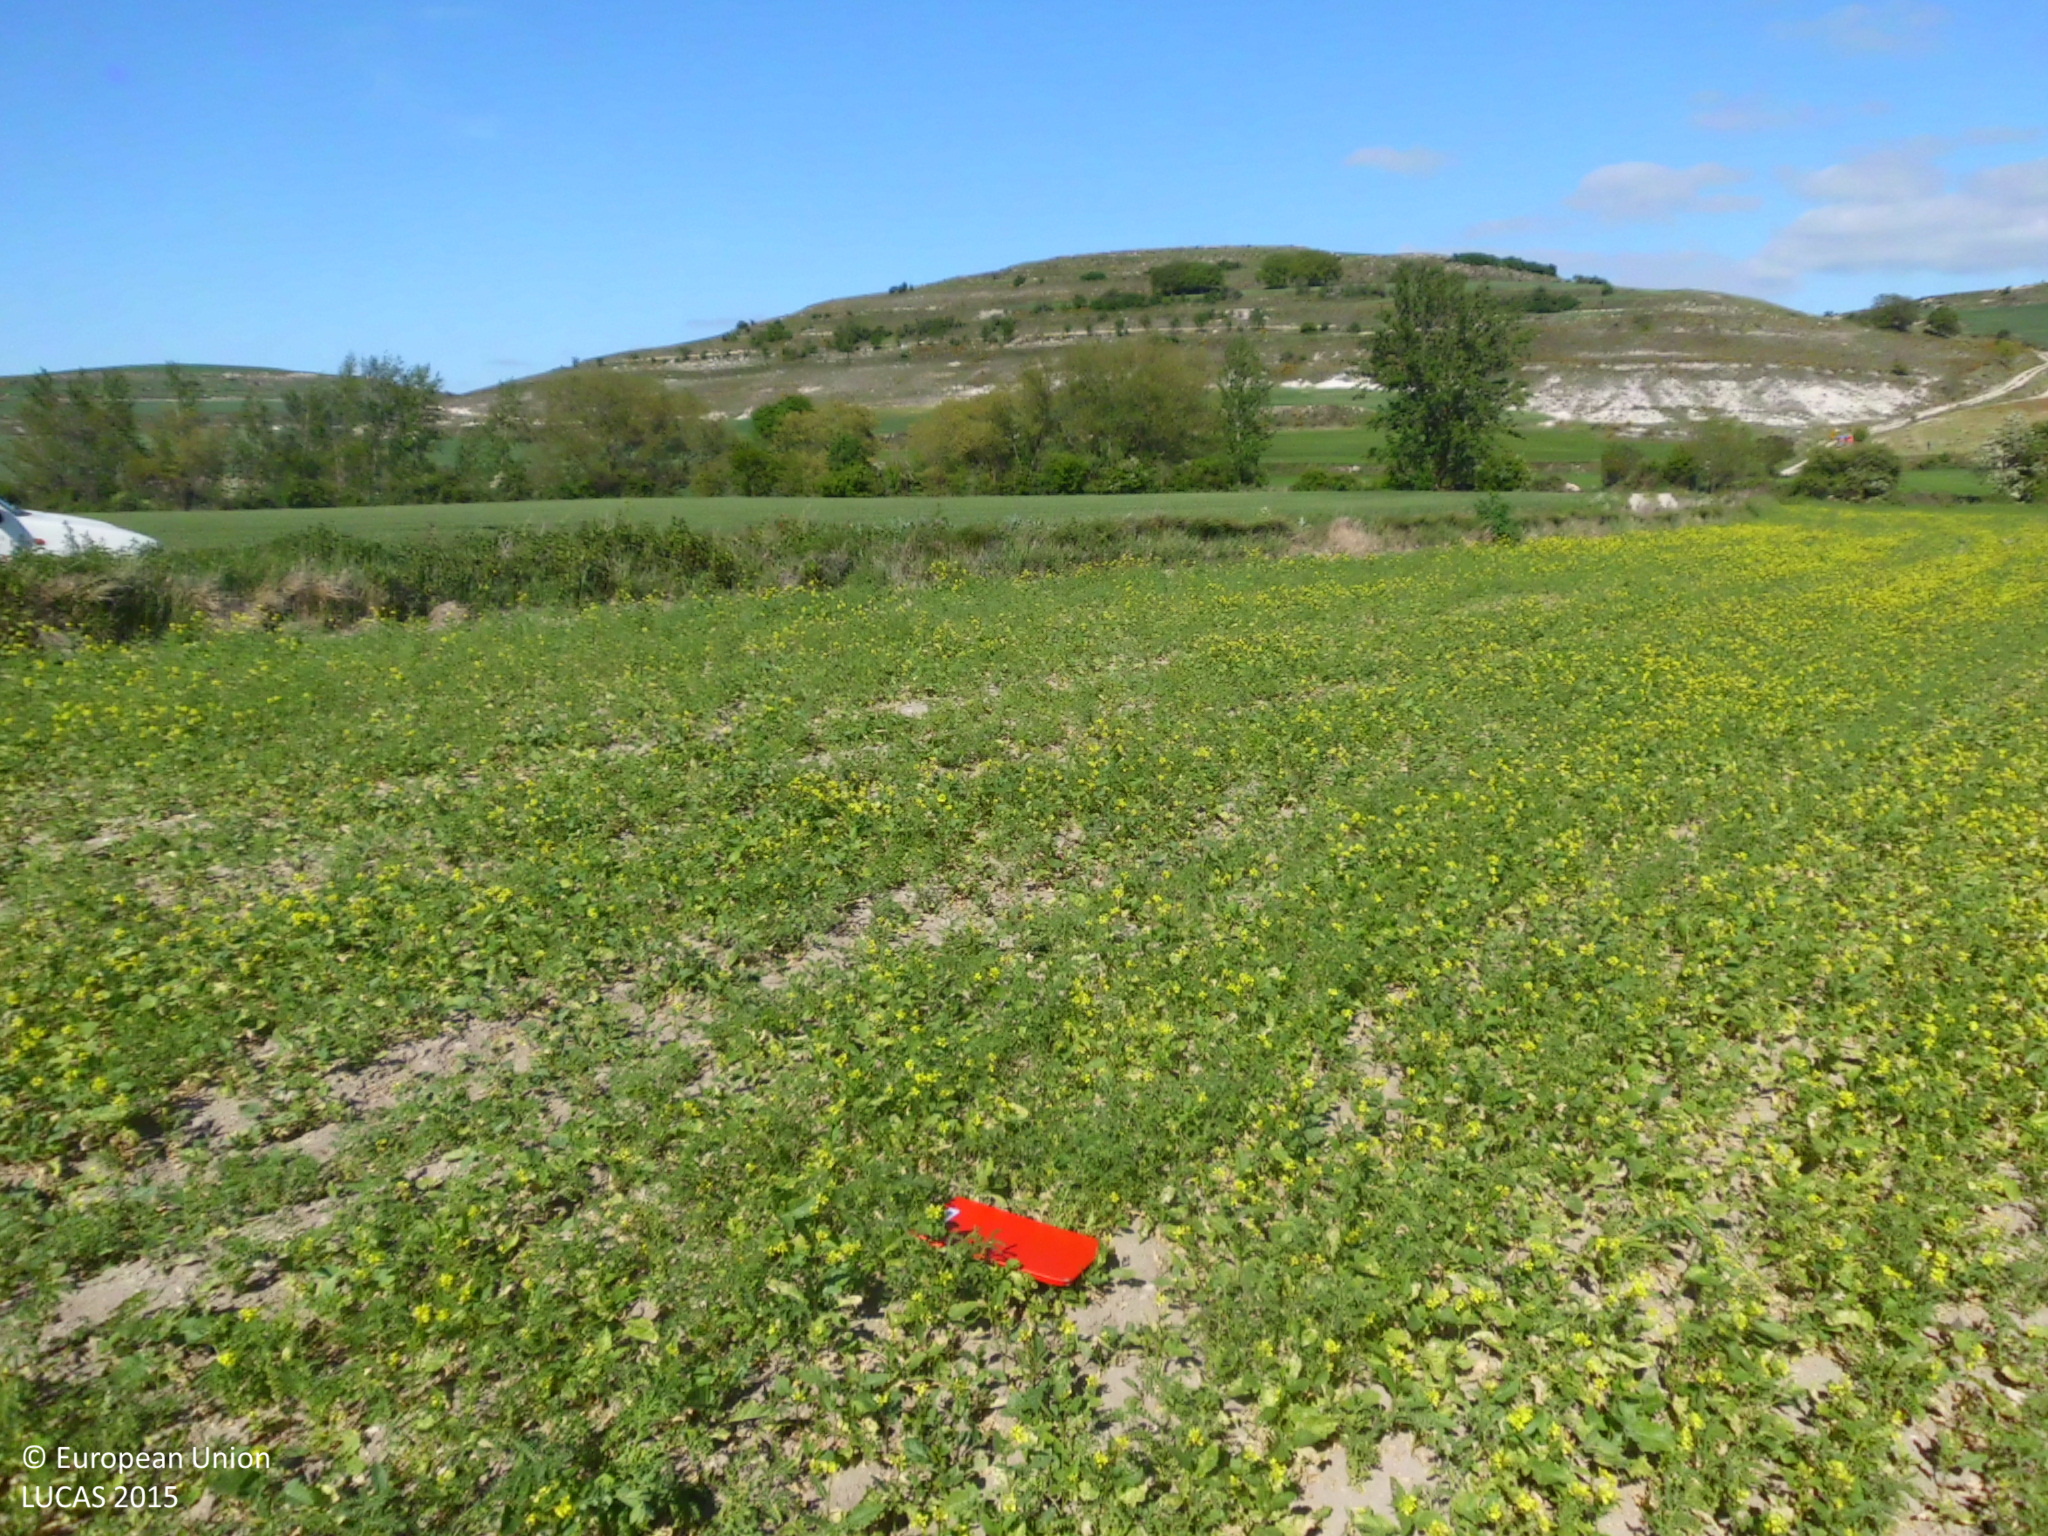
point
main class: Cropland
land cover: Lucerne
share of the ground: > 75 %
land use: Agriculture (excluding fallow land and kitchen gardens)
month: May
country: ES
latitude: 42.4533
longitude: -3.9394
